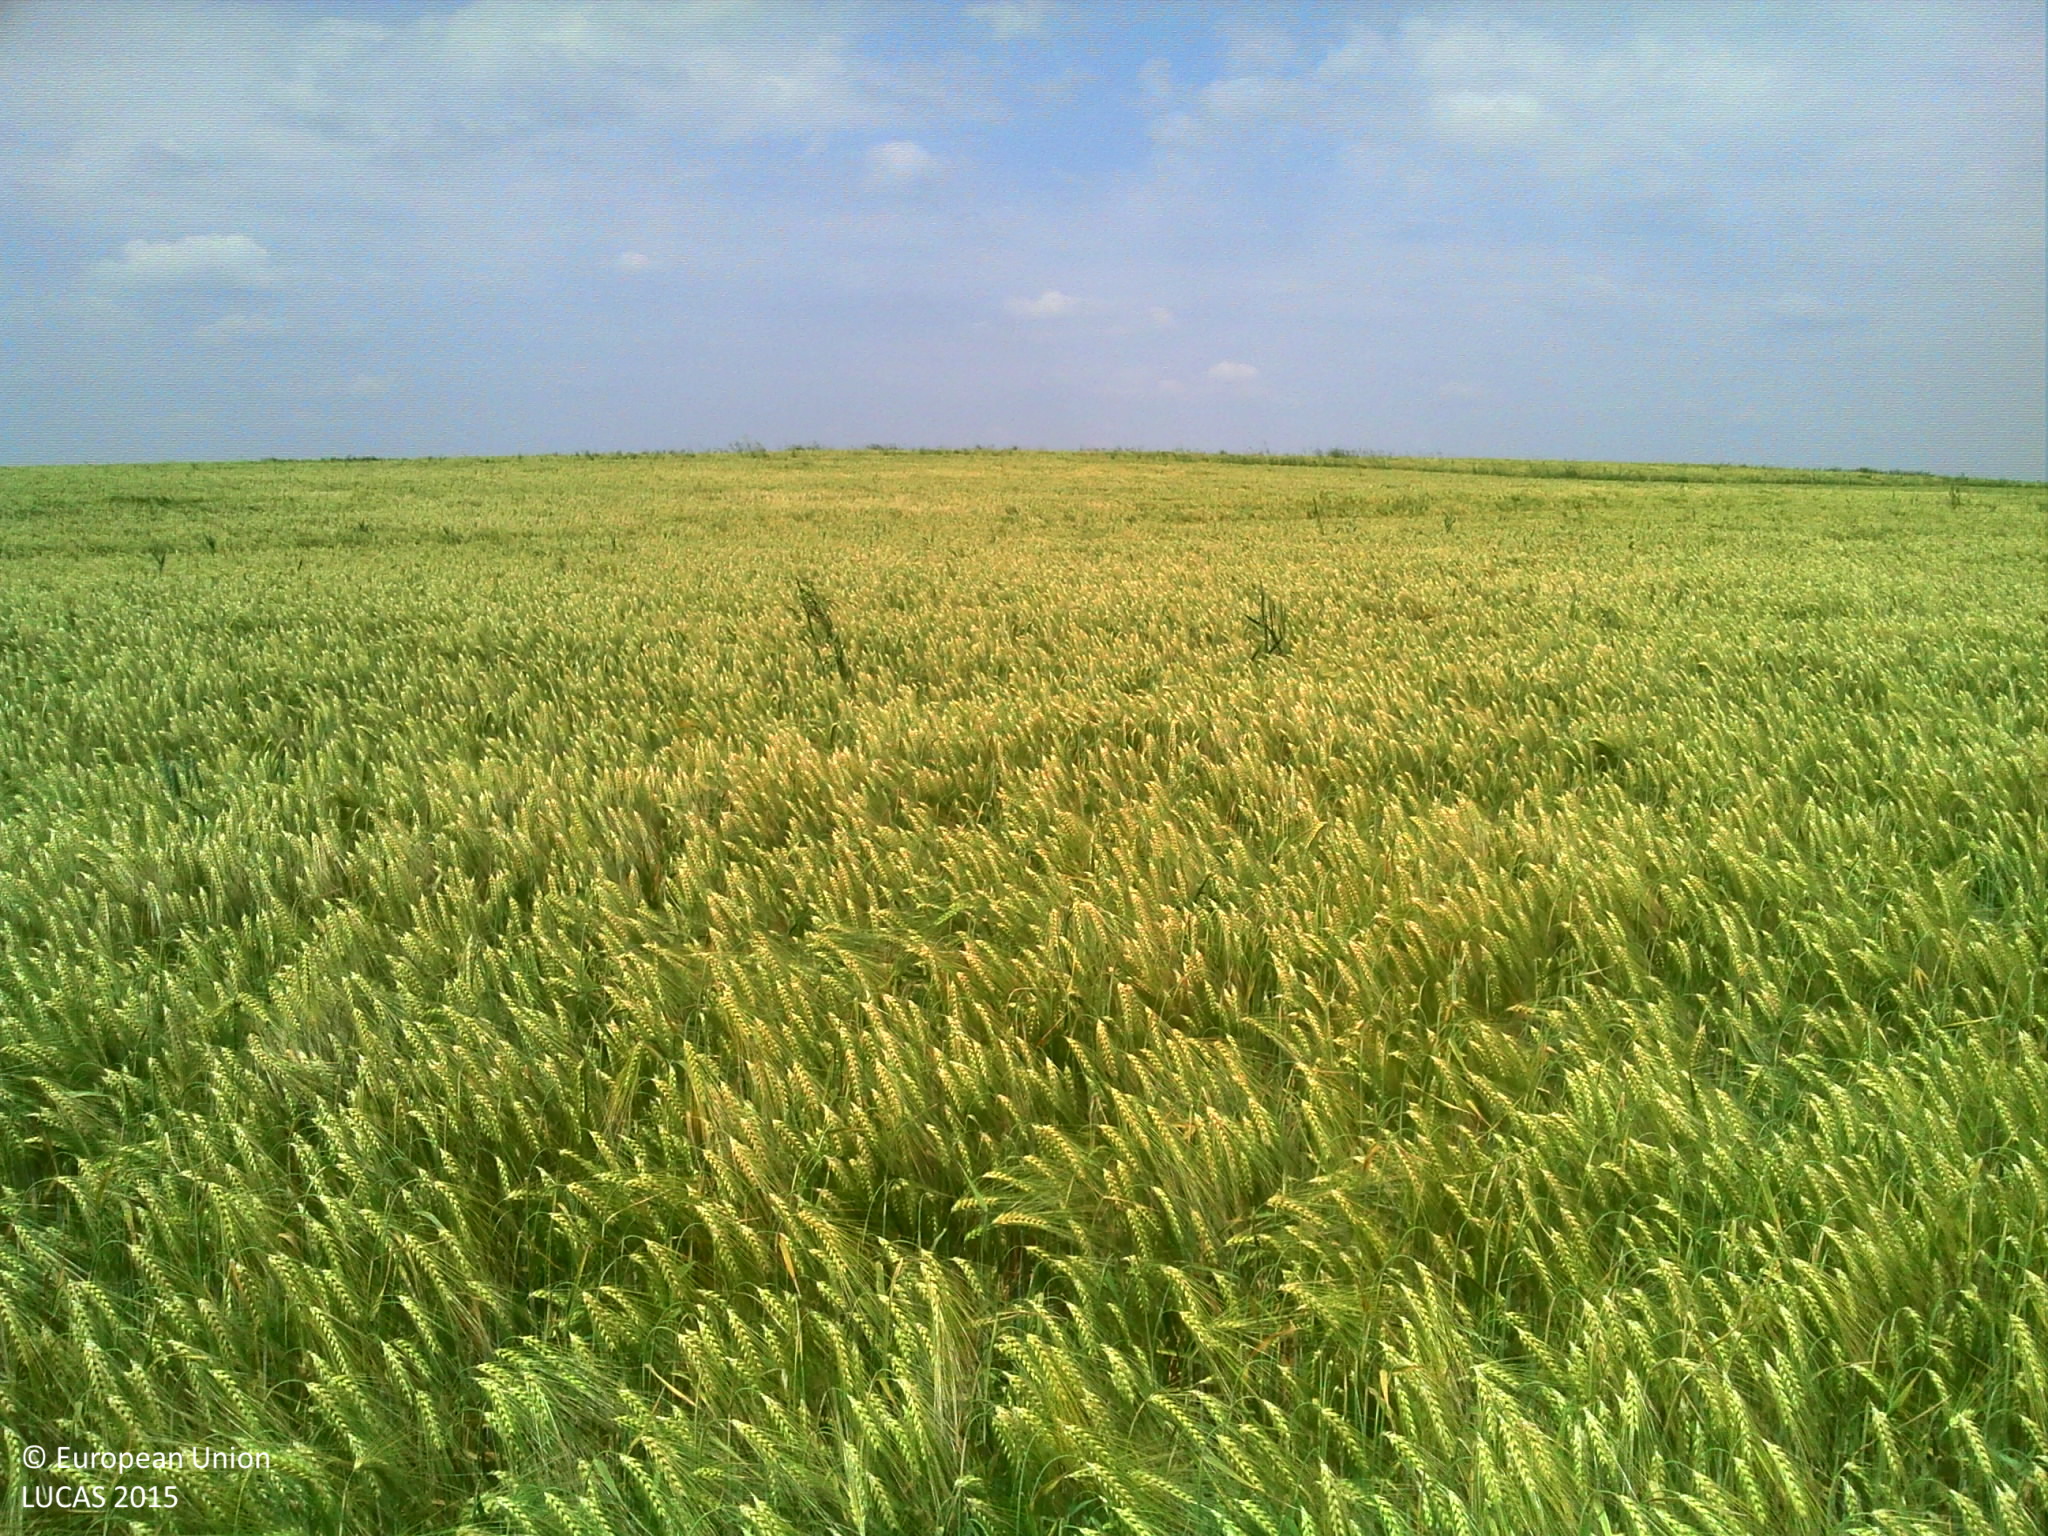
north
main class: Cropland
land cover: Barley
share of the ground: > 75 %
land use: Agriculture (excluding fallow land and kitchen gardens)
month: June
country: FR
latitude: 48.5012
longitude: 6.2242
